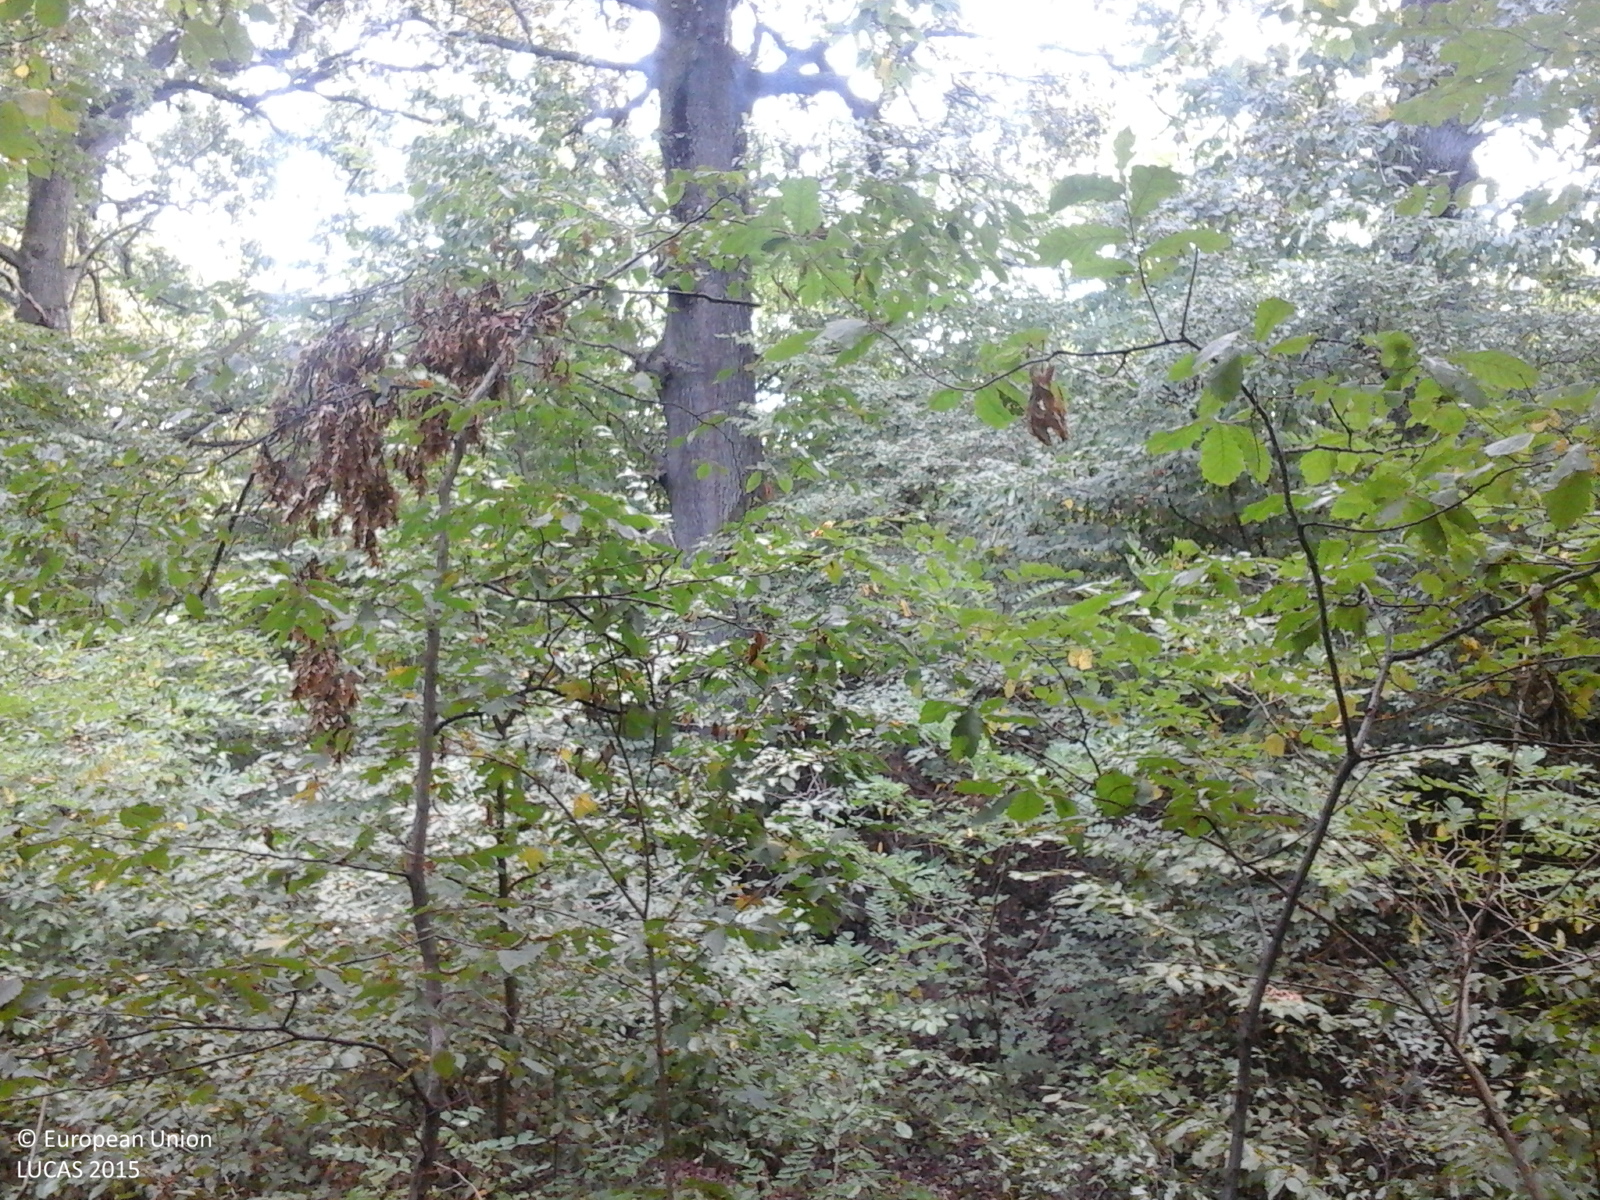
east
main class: Woodland
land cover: Broadleaved woodland
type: mesophytic deciduous forest
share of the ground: > 75 %
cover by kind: broadleaved forest trees 90 %, shrubs 5 %, herbaceous plants 5 %
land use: Forestry
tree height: > 5 m
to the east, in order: Broadleaved woodland; Ditches and canals; Broadleaved woodland; Grassland without tree/shrub cover; Shrubland with sparse tree cover; Ditches and canals; Broadleaved woodland; Grassland without tree/shrub cover; Ditches and canals; Tracks; Ditches and canals; Grassland without tree/shrub cover
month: September
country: RO
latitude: 47.5222
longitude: 22.8521
